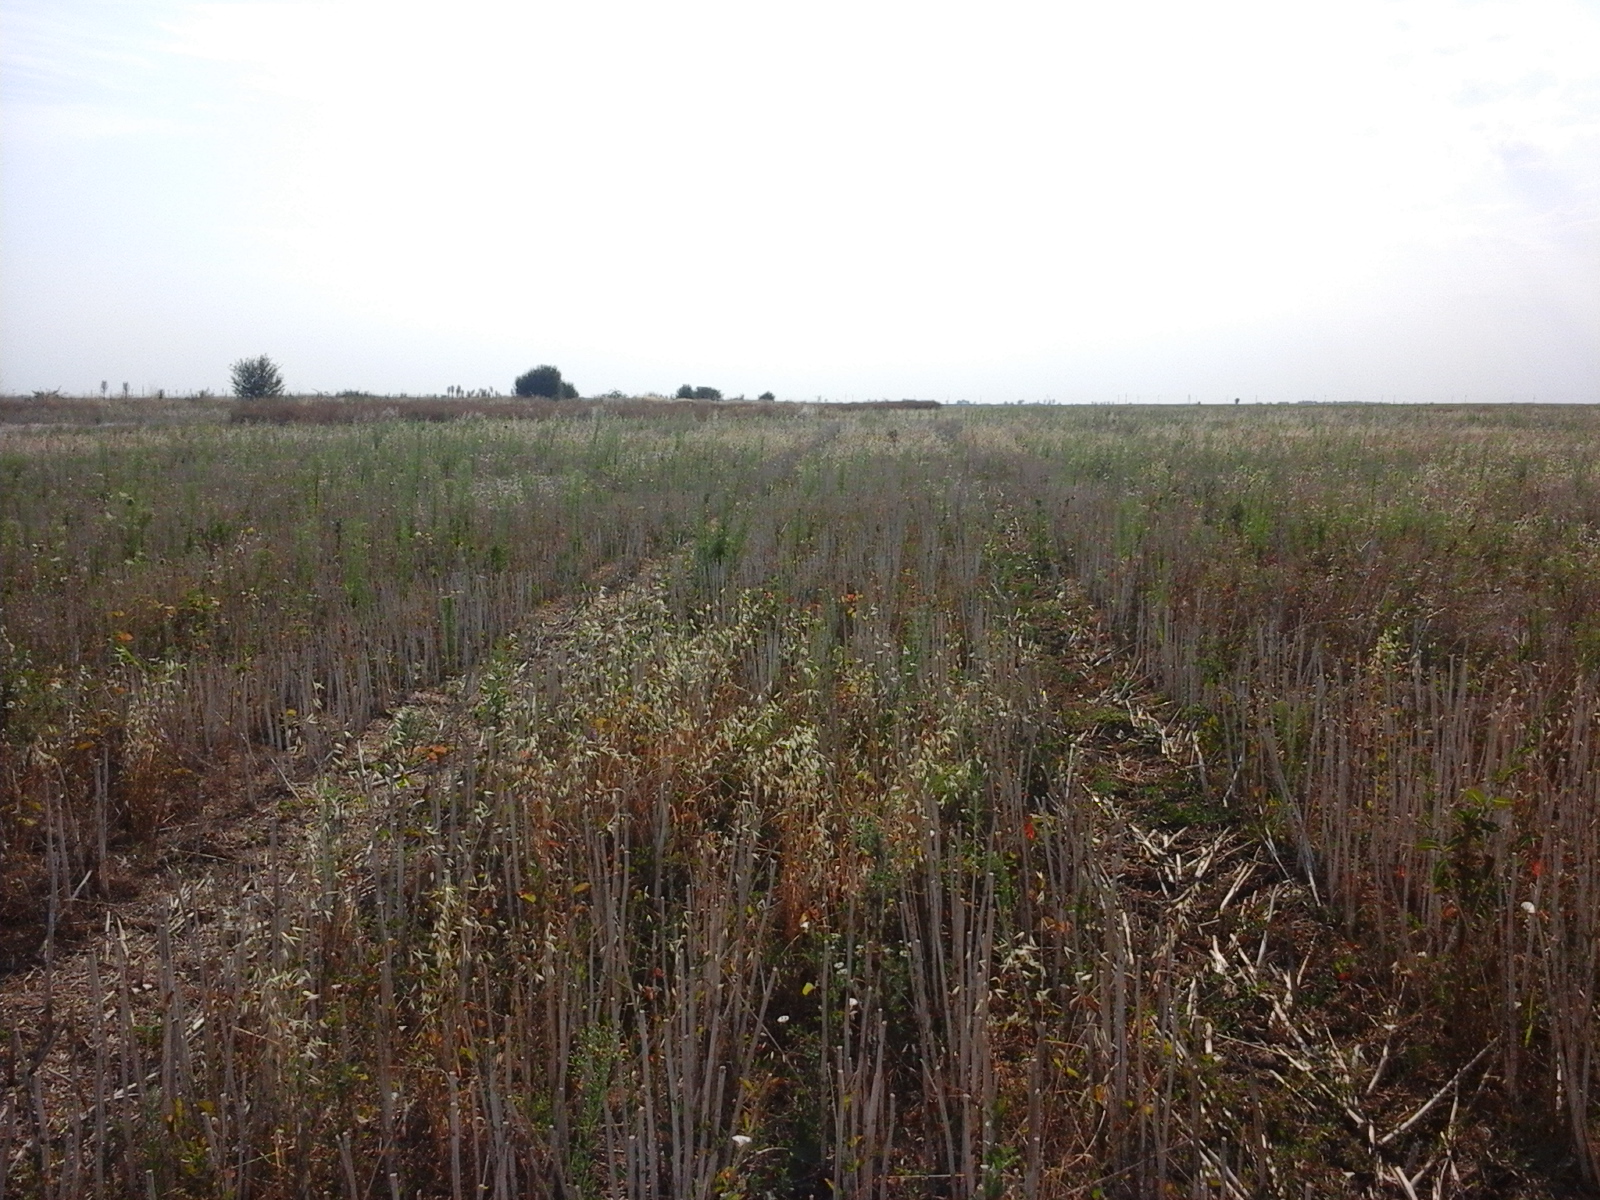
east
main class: Cropland
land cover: Rape and turnip rape
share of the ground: > 75 %
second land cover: Spontaneously vegetated surfaces
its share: 50 - 75 %
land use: Agriculture (excluding fallow land and kitchen gardens)
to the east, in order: Rape and turnip rape; Spontaneously vegetated surfaces; Common wheat; Spontaneously vegetated surfaces
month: August
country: RO
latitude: 44.1439
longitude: 23.7431
